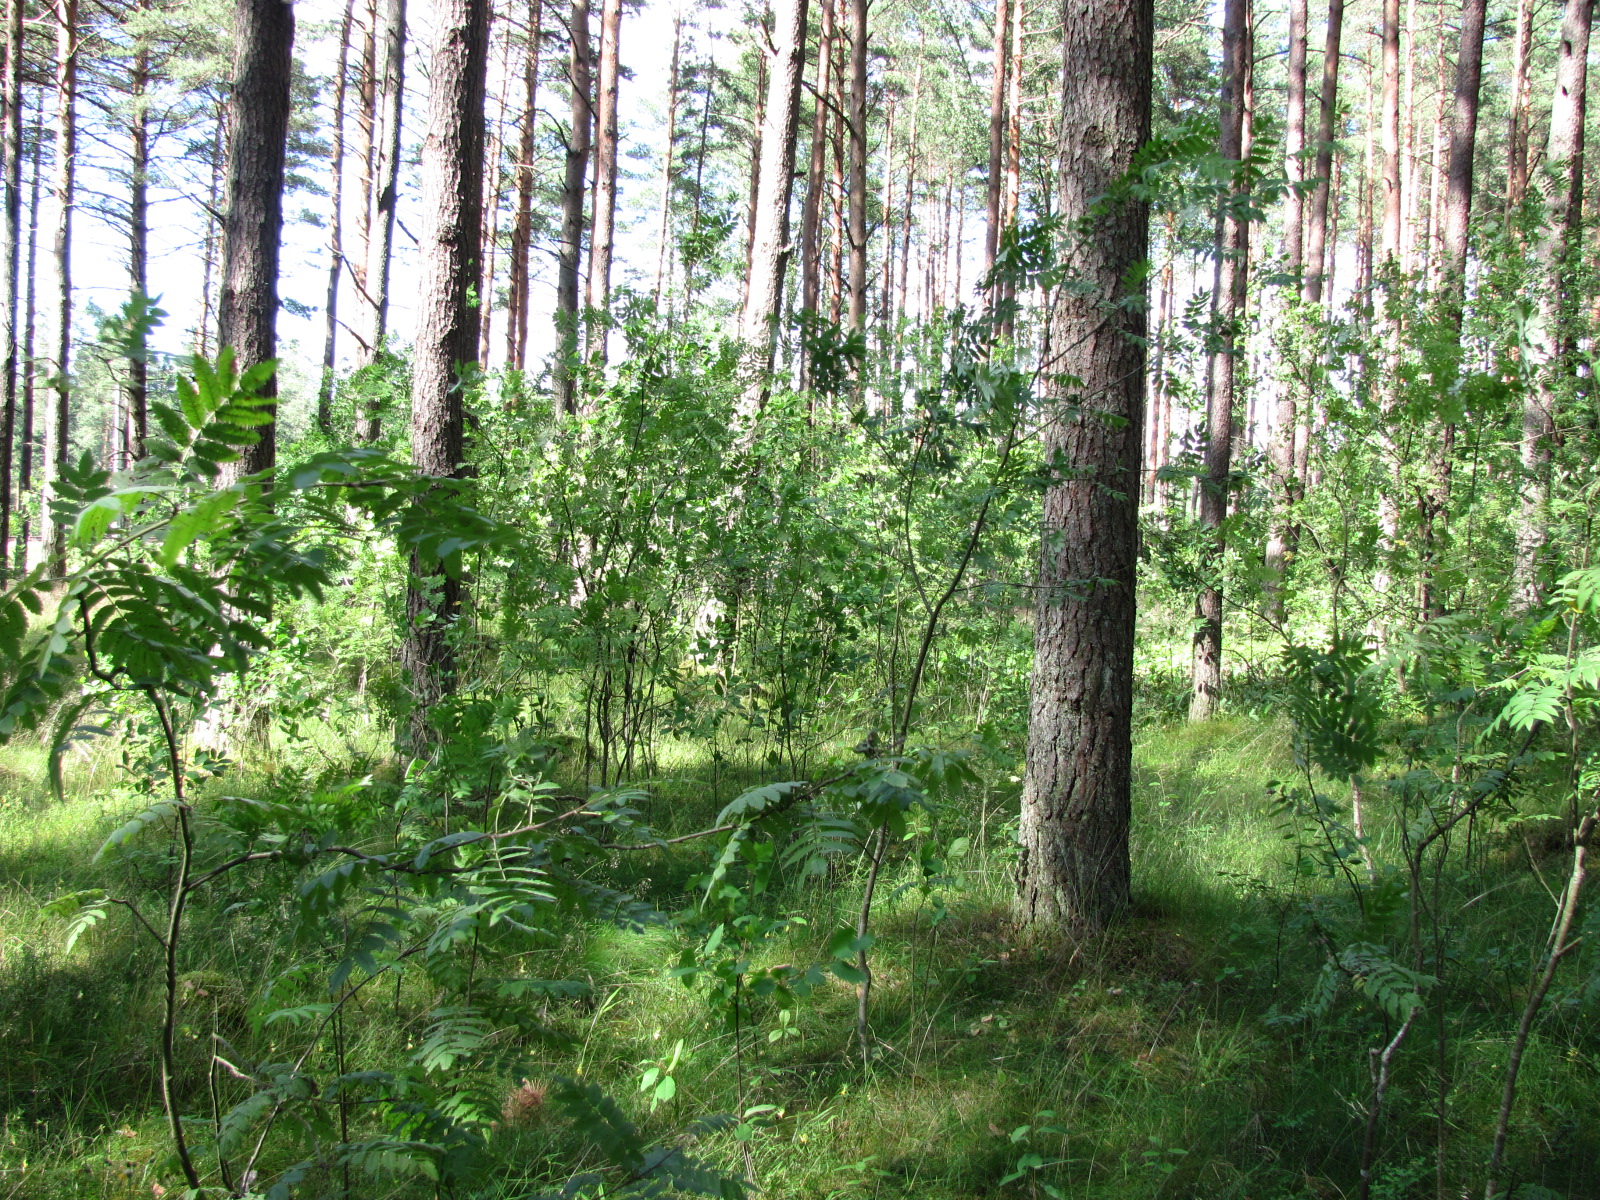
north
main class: Woodland
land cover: Pine dominated mixed woodland
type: hemiboreal forest and nemoral coniferous forest and mixed broadleaved-coniferous forest
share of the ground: > 75 %
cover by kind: coniferous forest trees 55 %, broadleaved forest trees 25 %, herbaceous plants 15 %, shrubs 5 %
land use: Forestry
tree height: > 5 m
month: July
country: LV
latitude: 57.0097
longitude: 24.3002
